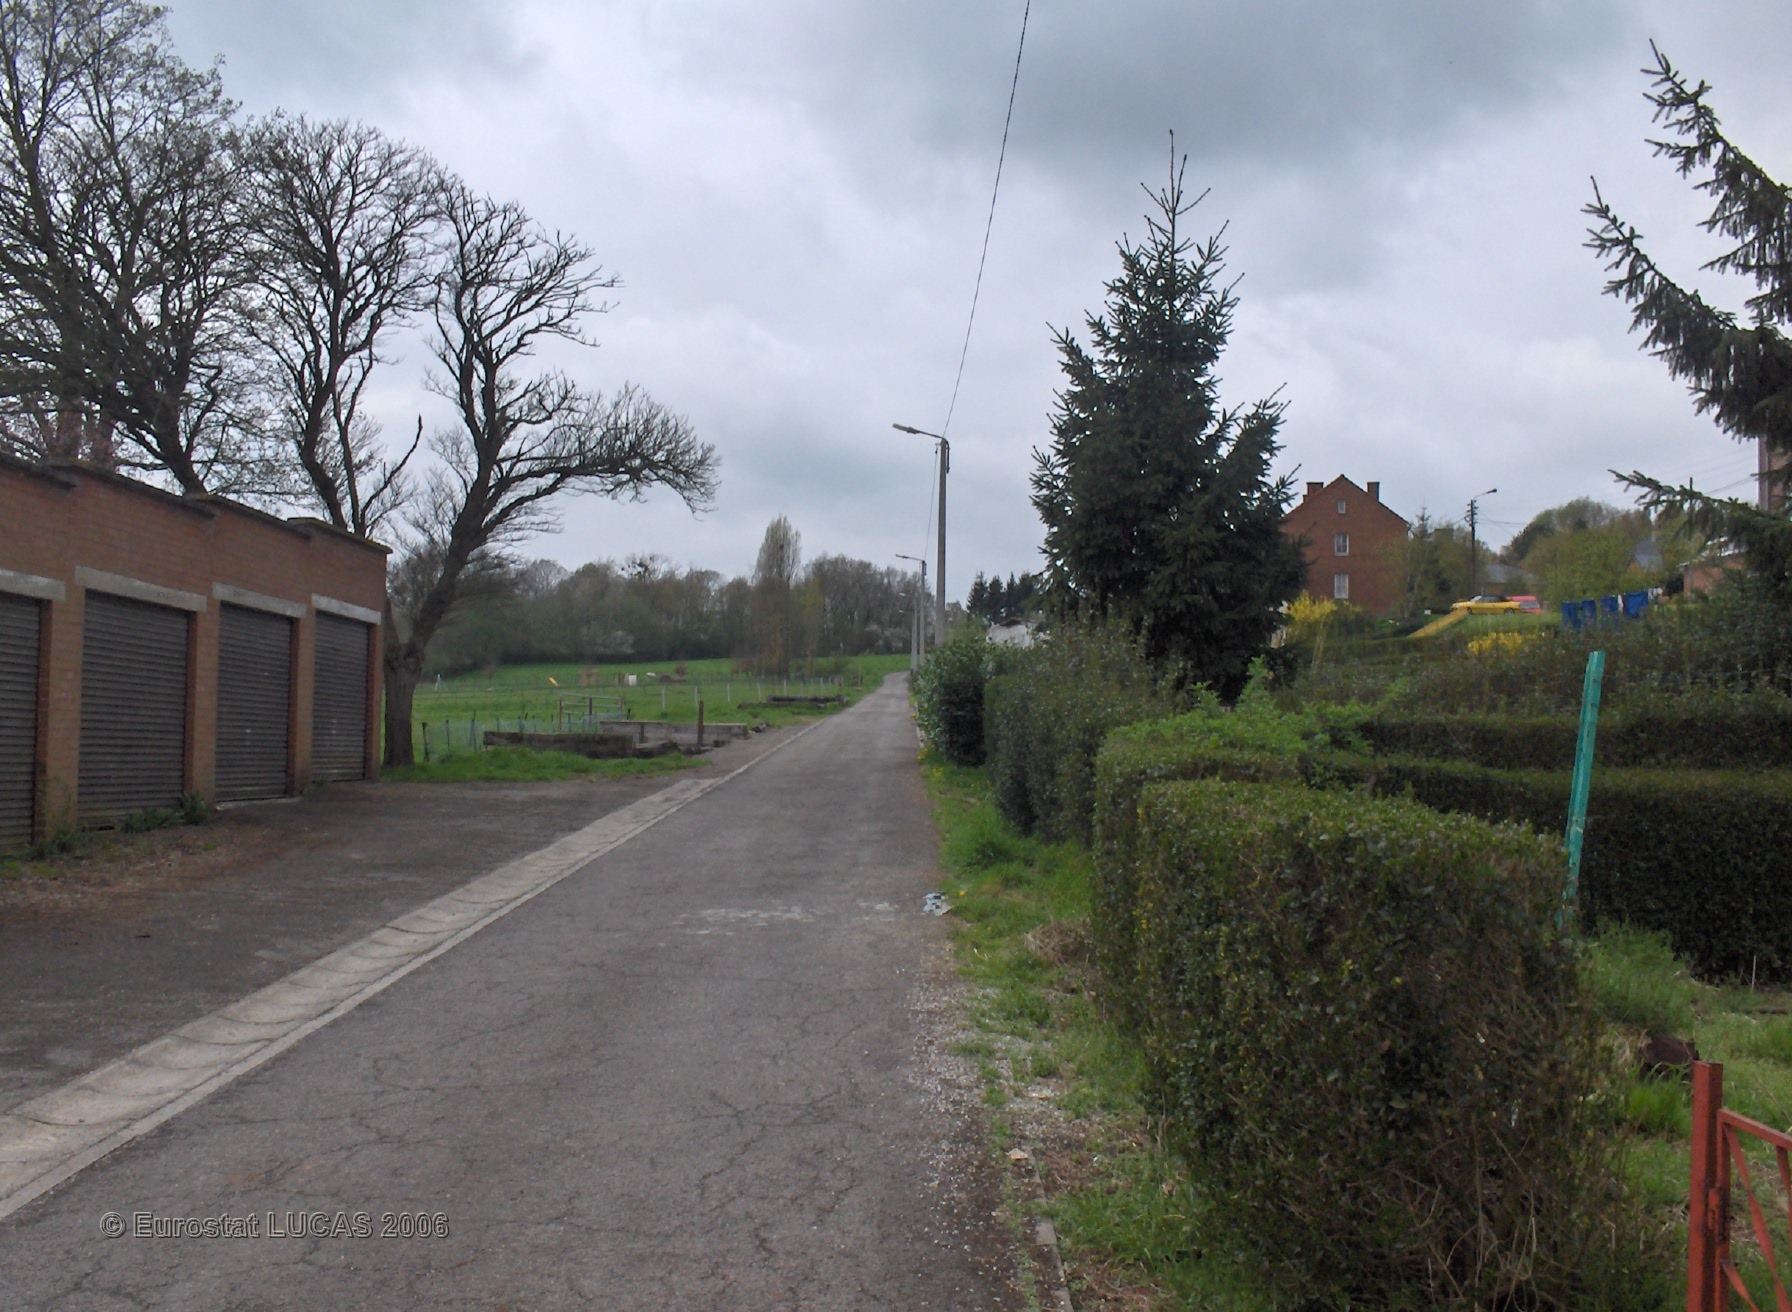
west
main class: Grassland
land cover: Grassland with sparse tree/shrub cover
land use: Residential
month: April
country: BE
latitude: 50.3593
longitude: 4.5280
